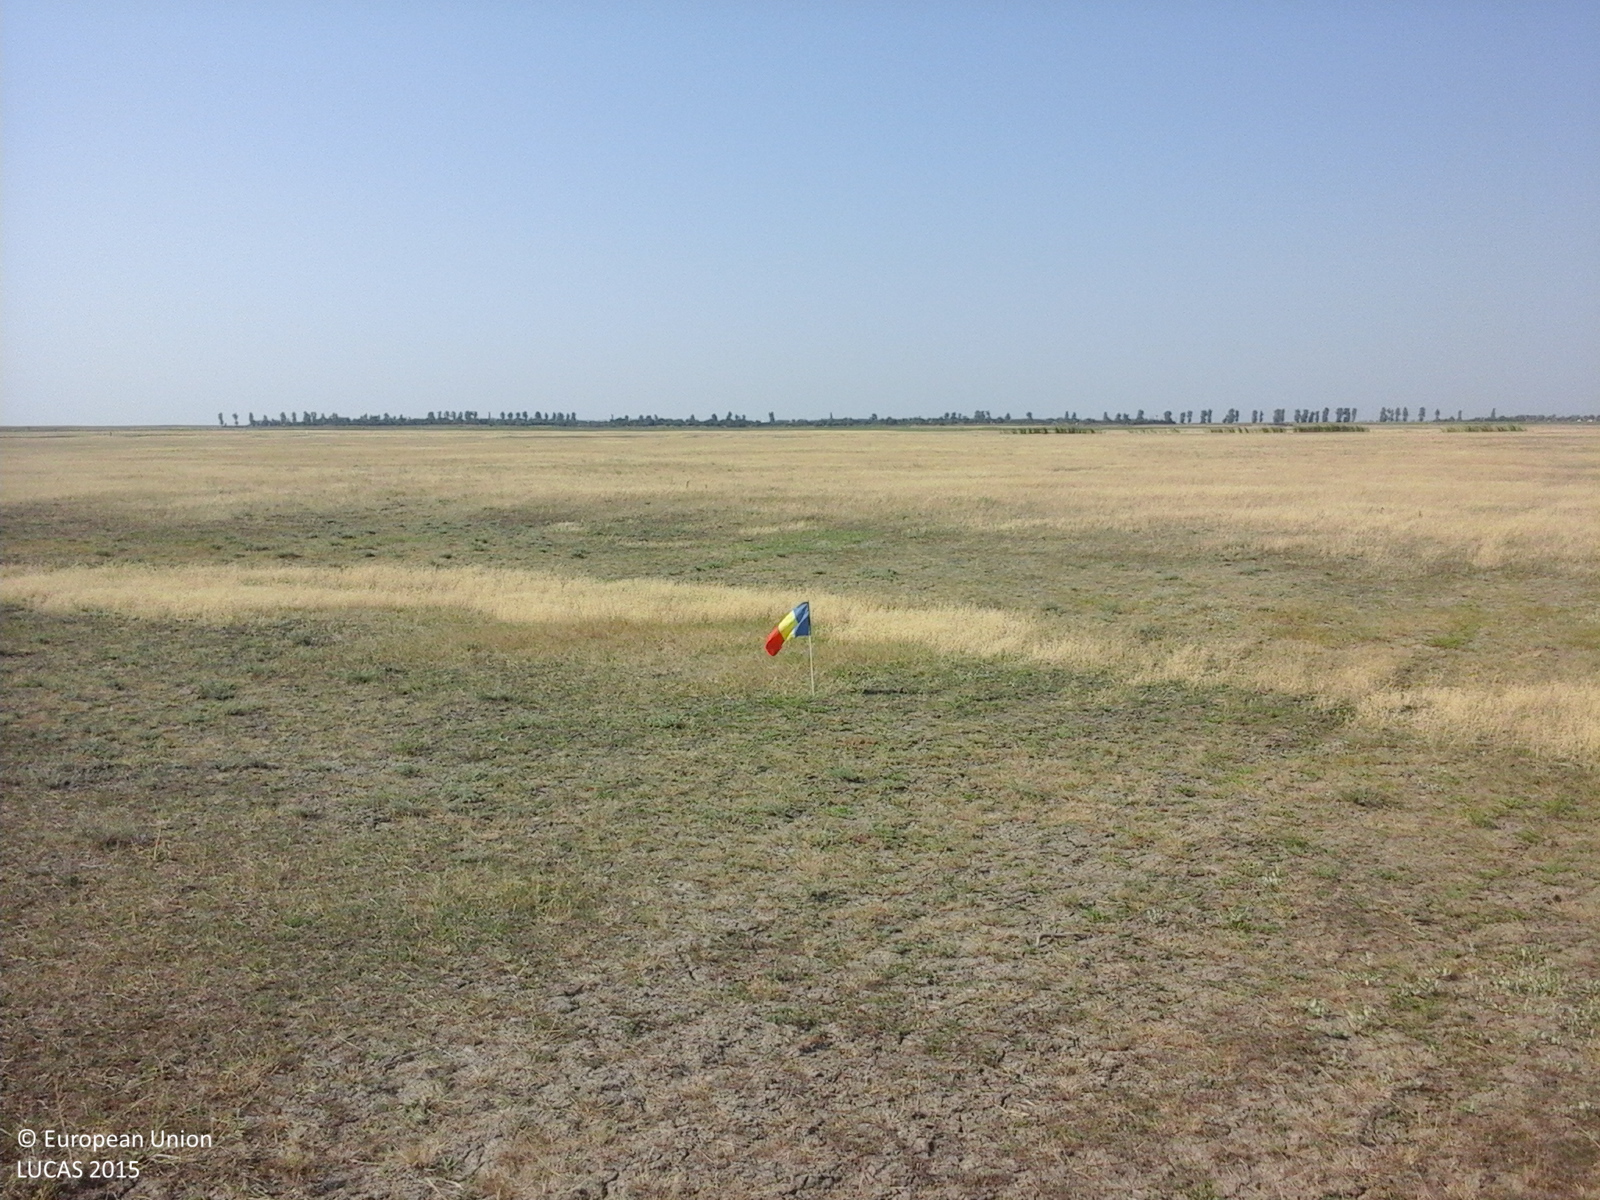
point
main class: Grassland
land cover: Grassland without tree/shrub cover
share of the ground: > 75 %
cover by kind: herbaceous plants 70 %, unconsolidated bare surface 30 %
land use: Agriculture (excluding fallow land and kitchen gardens)
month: July
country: RO
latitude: 44.9793
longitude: 27.4307
